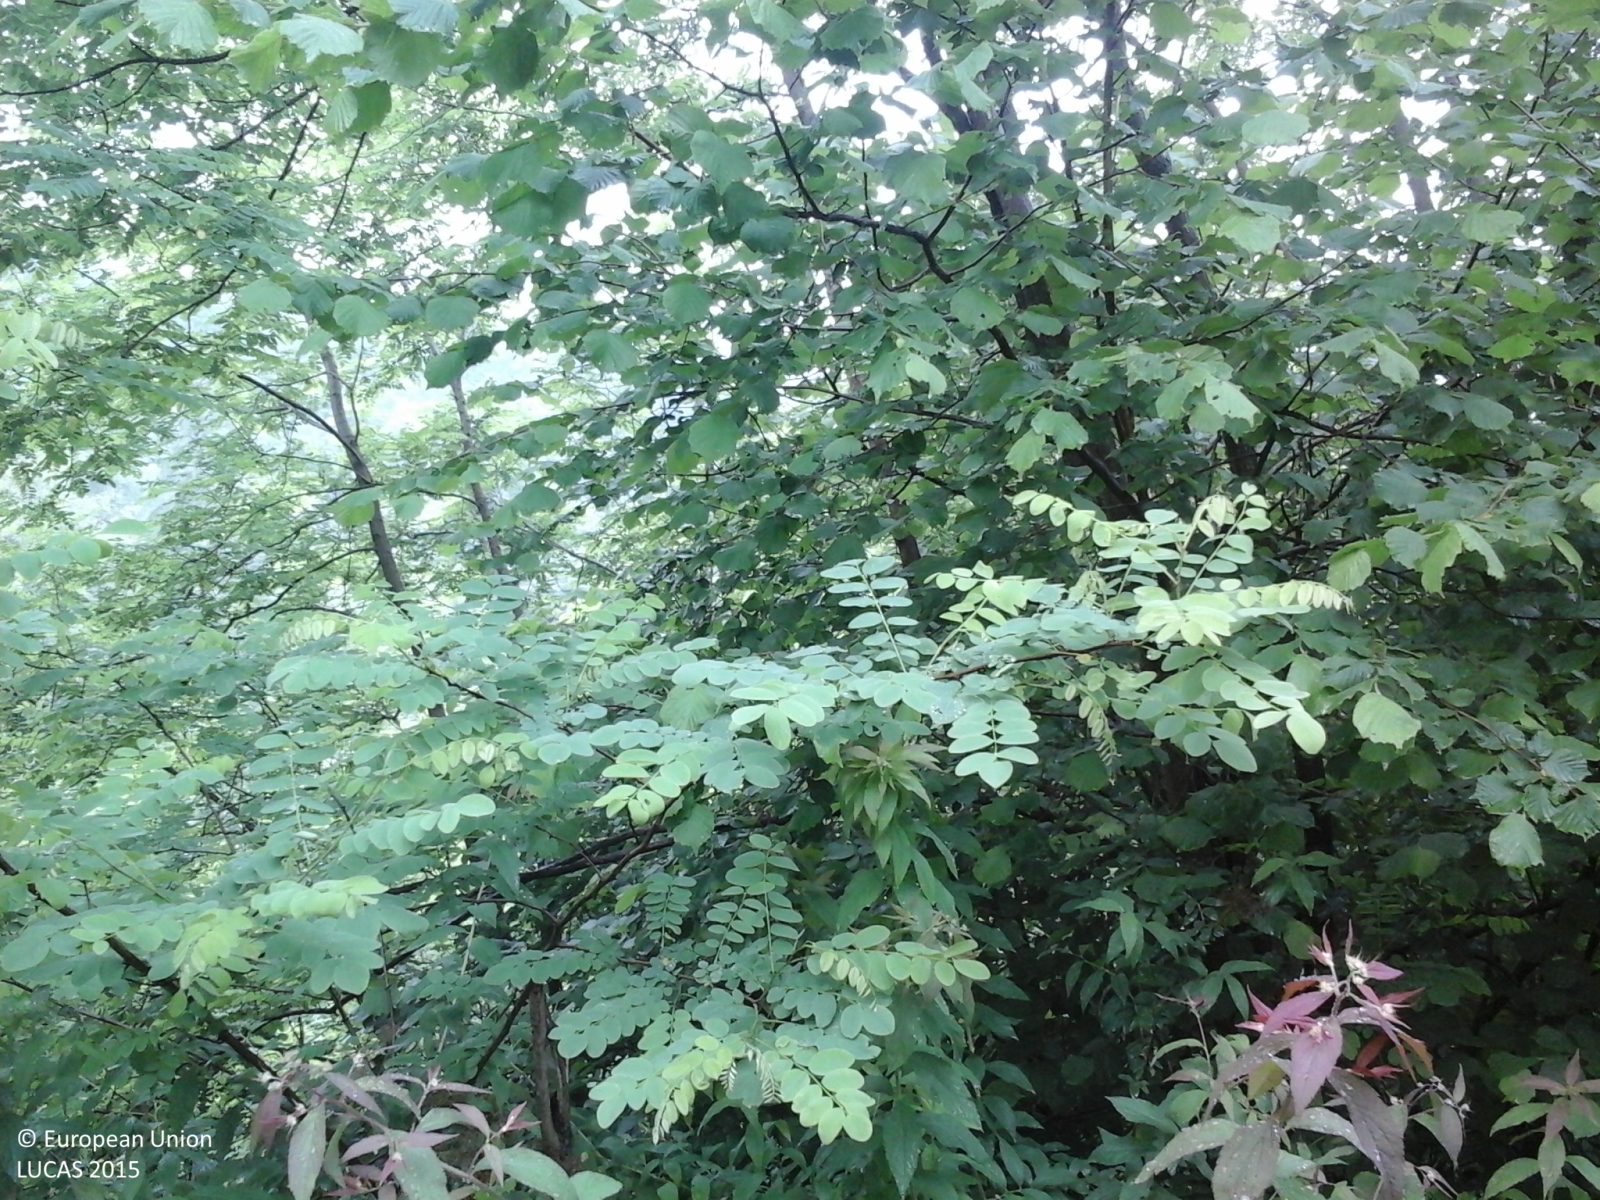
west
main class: Woodland
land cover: Broadleaved woodland
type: mesophytic deciduous forest
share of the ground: > 75 %
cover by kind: broadleaved forest trees 100 %
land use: Forestry
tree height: > 5 m
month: May
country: IT
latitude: 45.6512
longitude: 8.1935
